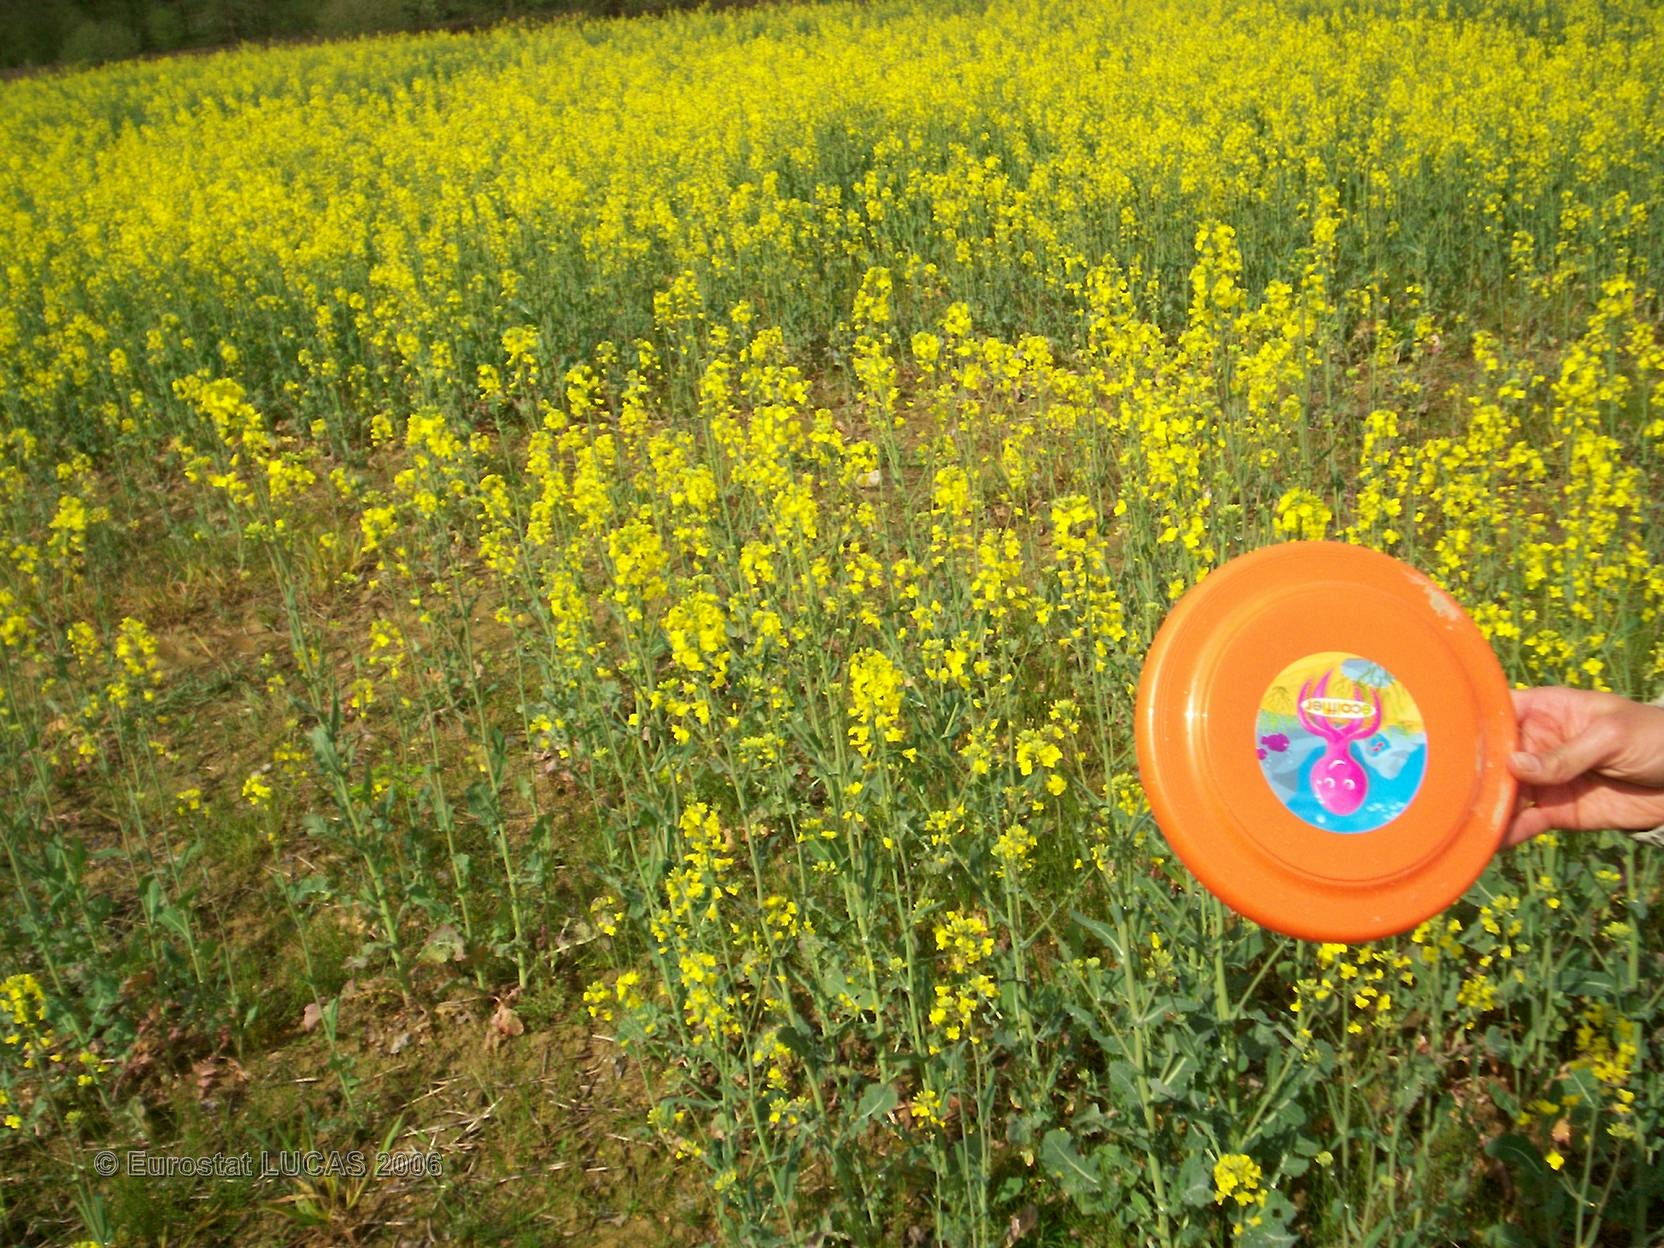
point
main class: Cropland
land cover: Rape and turnip rape
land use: Agriculture (excluding fallow land and kitchen gardens)
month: April
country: FR
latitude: 48.2229
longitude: -1.6374
